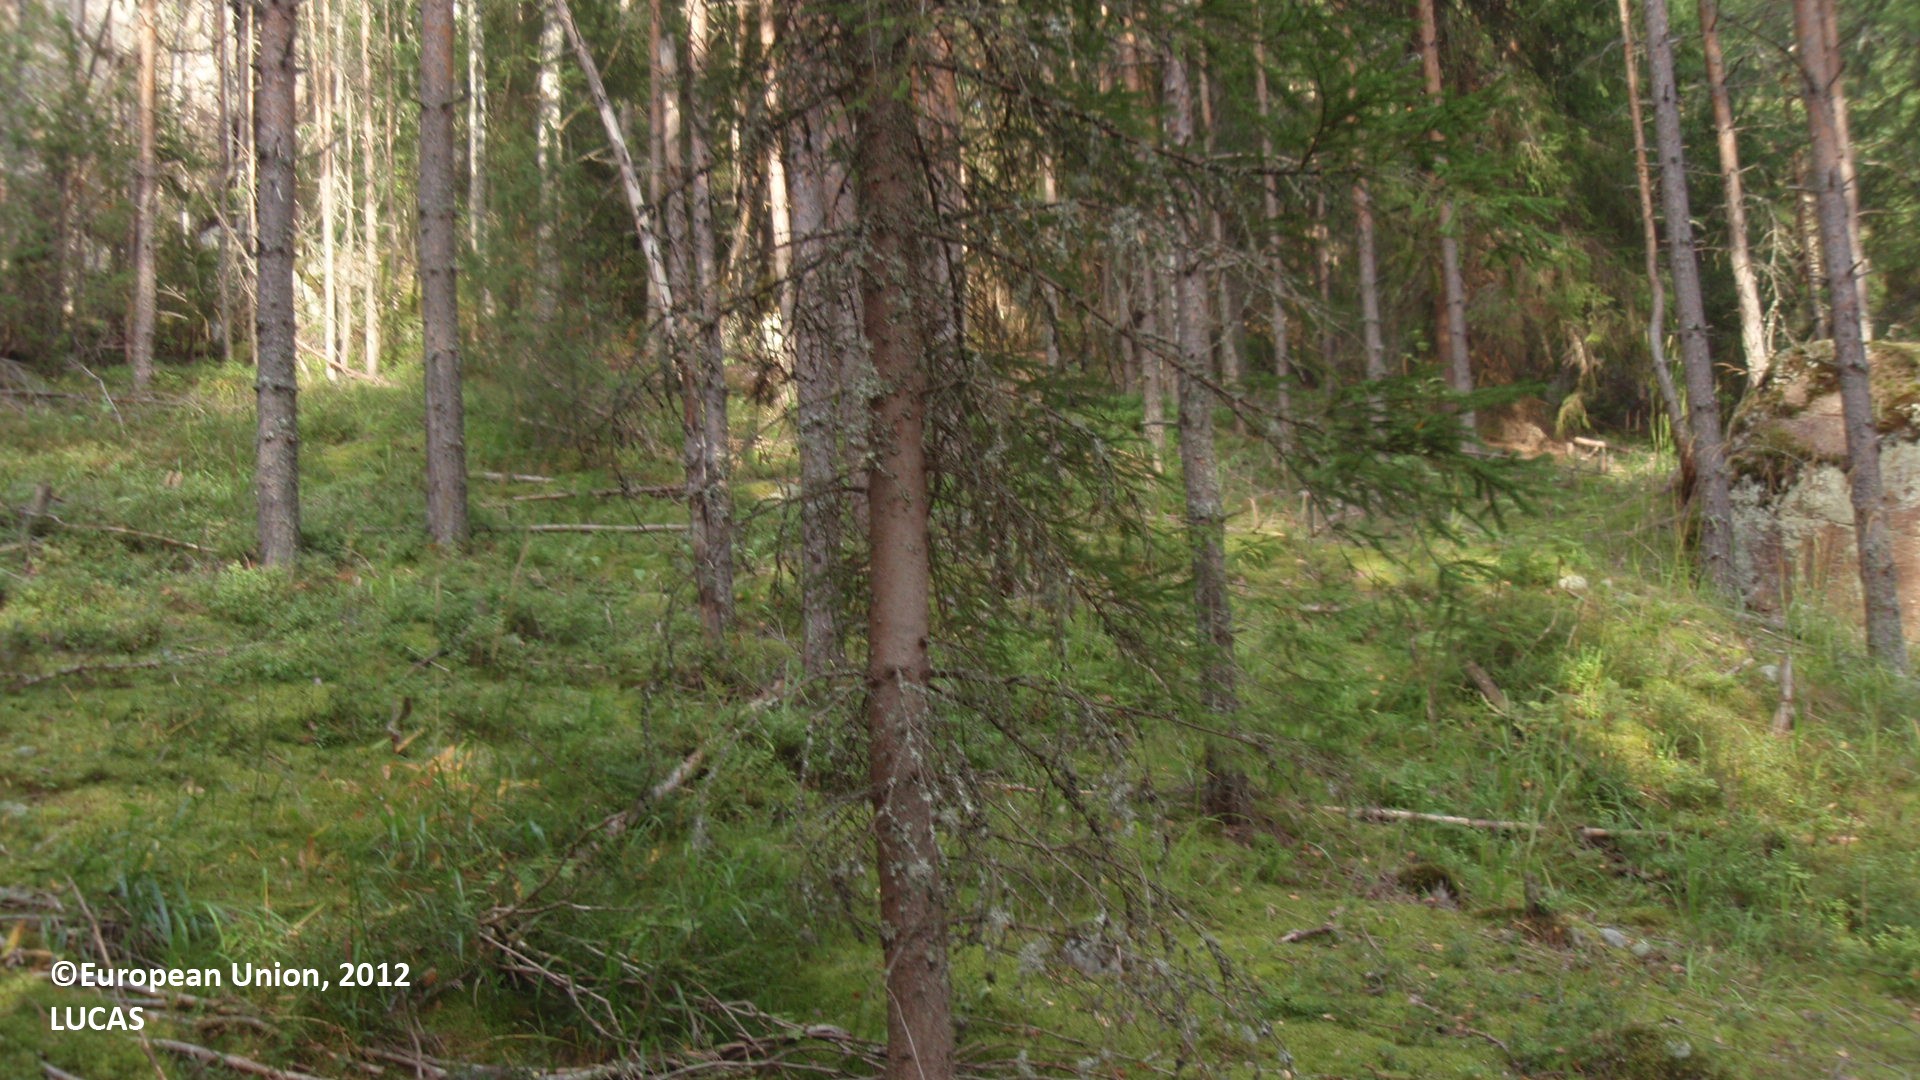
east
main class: Woodland
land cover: Pine dominated mixed woodland
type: boreal forest
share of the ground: 50 - 75 %
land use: Forestry
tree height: > 5 m
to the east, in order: Pine dominated mixed woodland; Lichens and moss; Pine dominated mixed woodland; Lichens and moss; Pine dominated coniferous woodland; Pine dominated mixed woodland
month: August
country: FI
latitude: 60.7248
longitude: 27.1684
